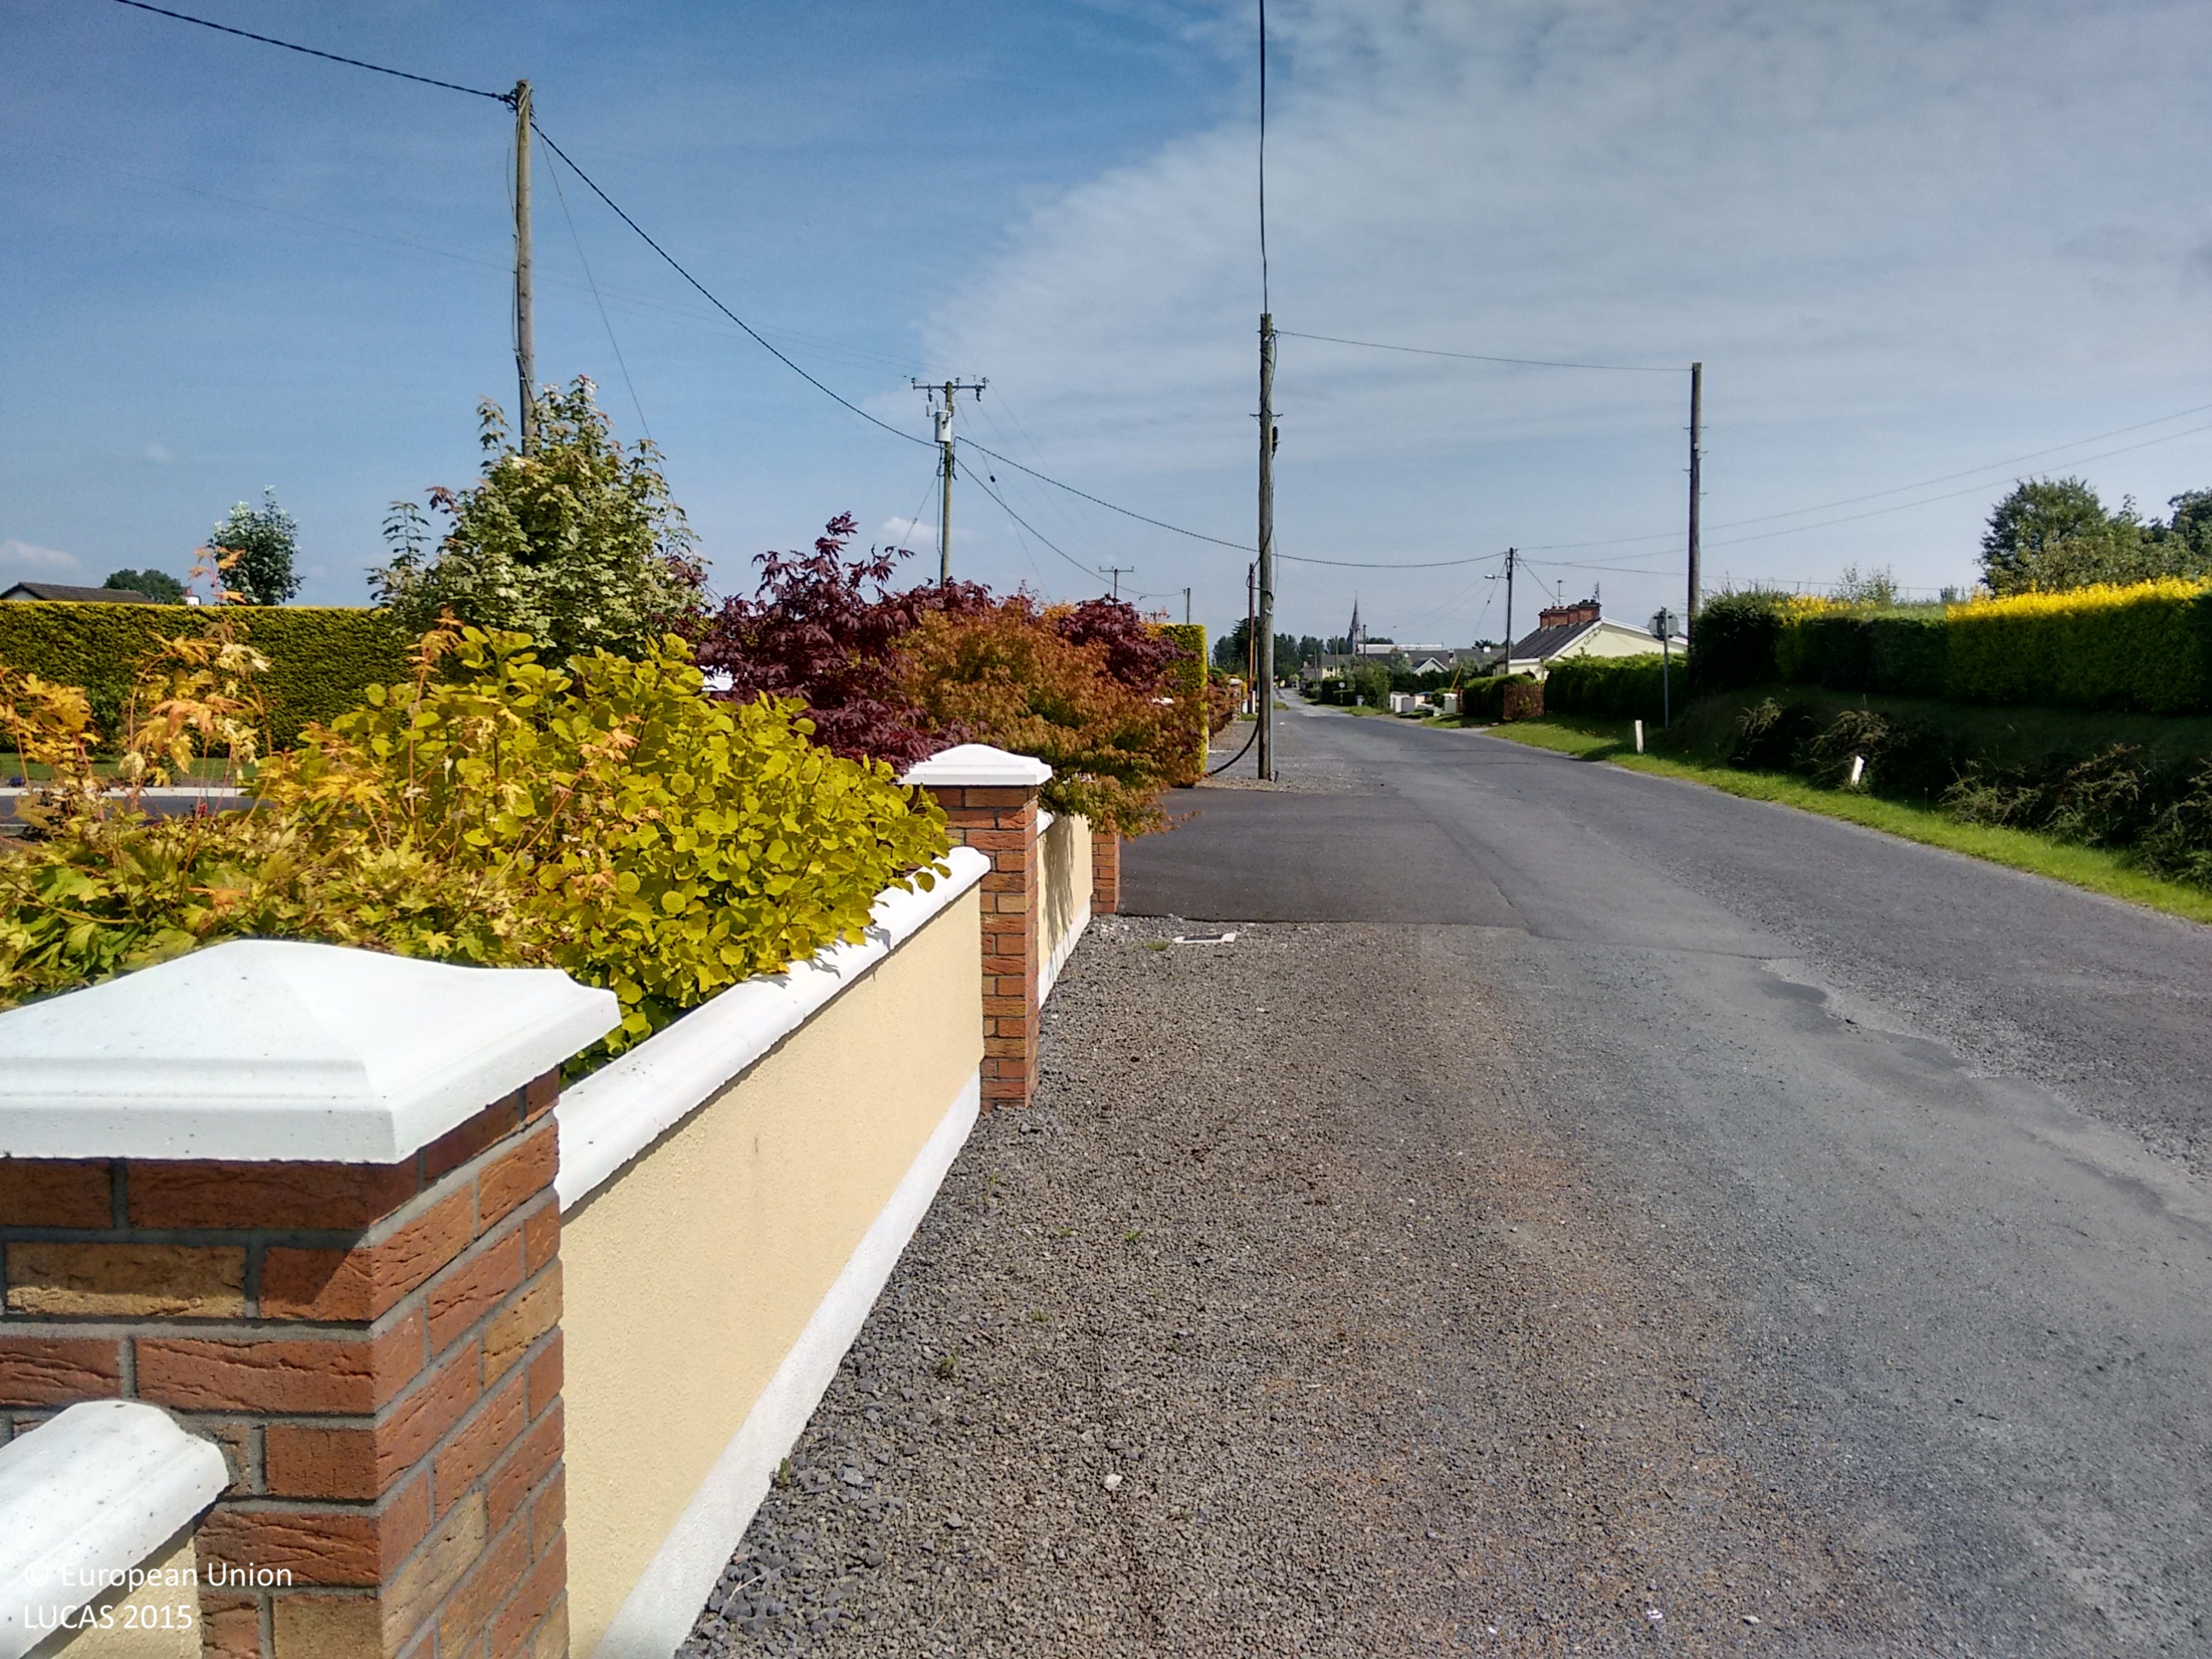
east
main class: Grassland
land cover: Grassland with sparse tree/shrub cover
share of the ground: > 75 %
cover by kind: herbaceous plants 90 %, broadleaved forest trees 5 %, shrubs 5 %
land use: Residential
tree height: < 5 m
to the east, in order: Grassland with sparse tree/shrub cover; Artificial constructions in urban areas; Grassland without tree/shrub cover
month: August
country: IE
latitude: 52.9990
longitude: -7.4872
